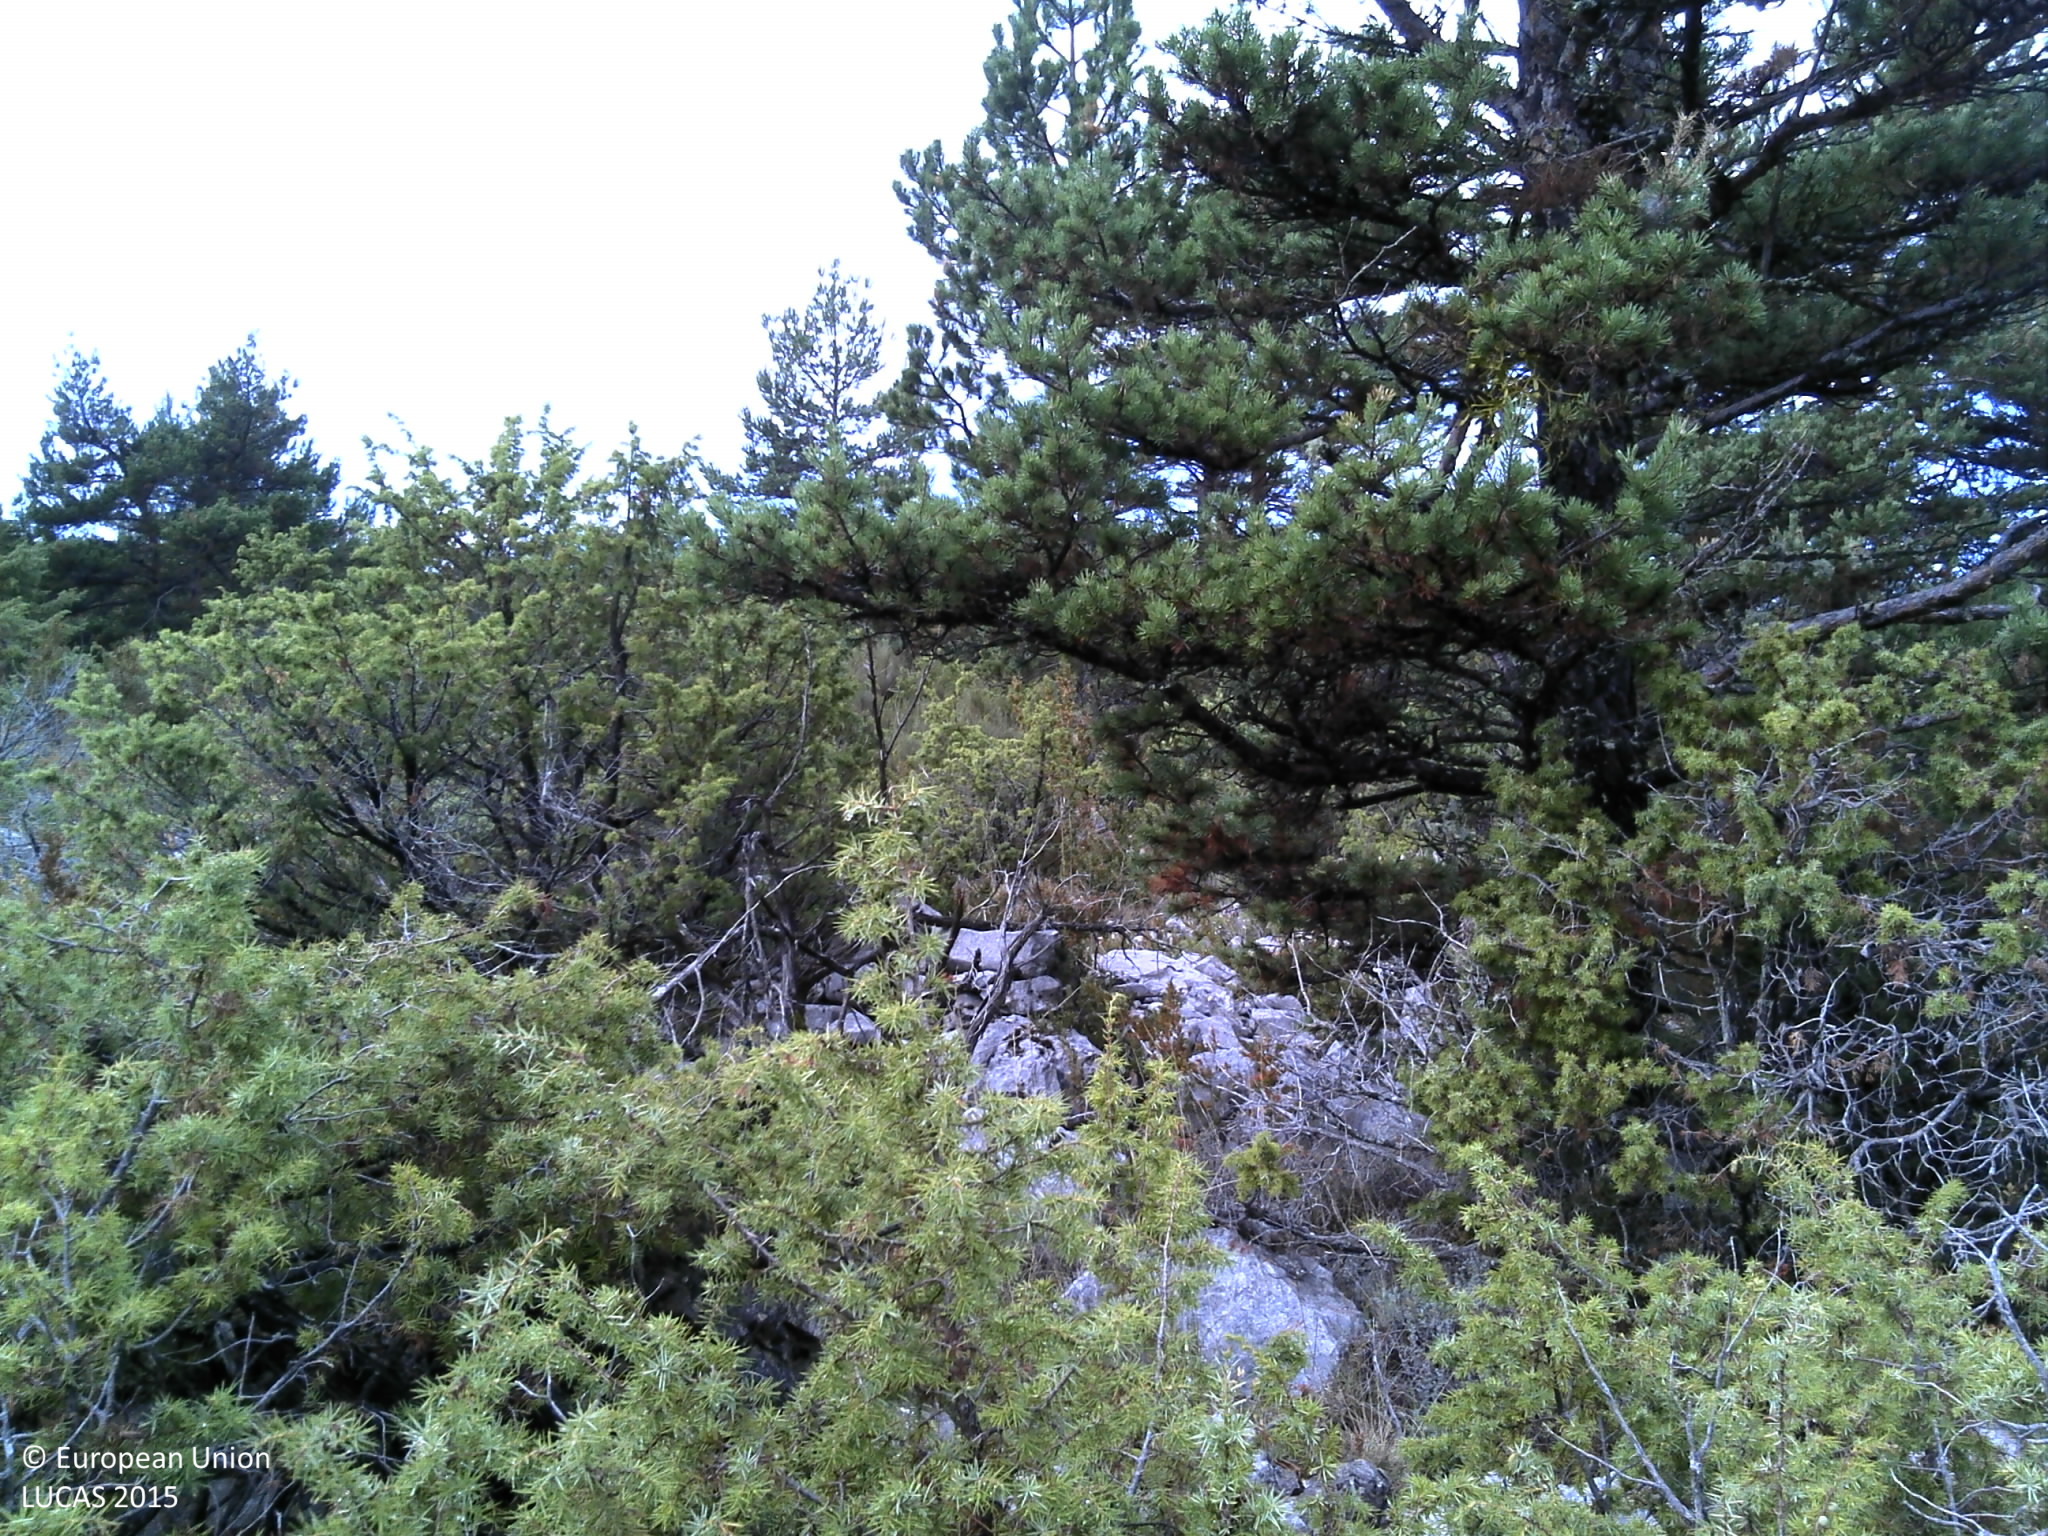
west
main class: Woodland
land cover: Pine dominated coniferous woodland
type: coniferous forest of the mediterranean region
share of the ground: > 75 %
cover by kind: coniferous forest trees 75 %, shrubs 15 %, lichens and mosses 5 %, consolidated bare surface 5 %
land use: Semi-natural and natural areas not in use
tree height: > 5 m
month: September
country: FR
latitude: 43.7471
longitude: 6.4192
